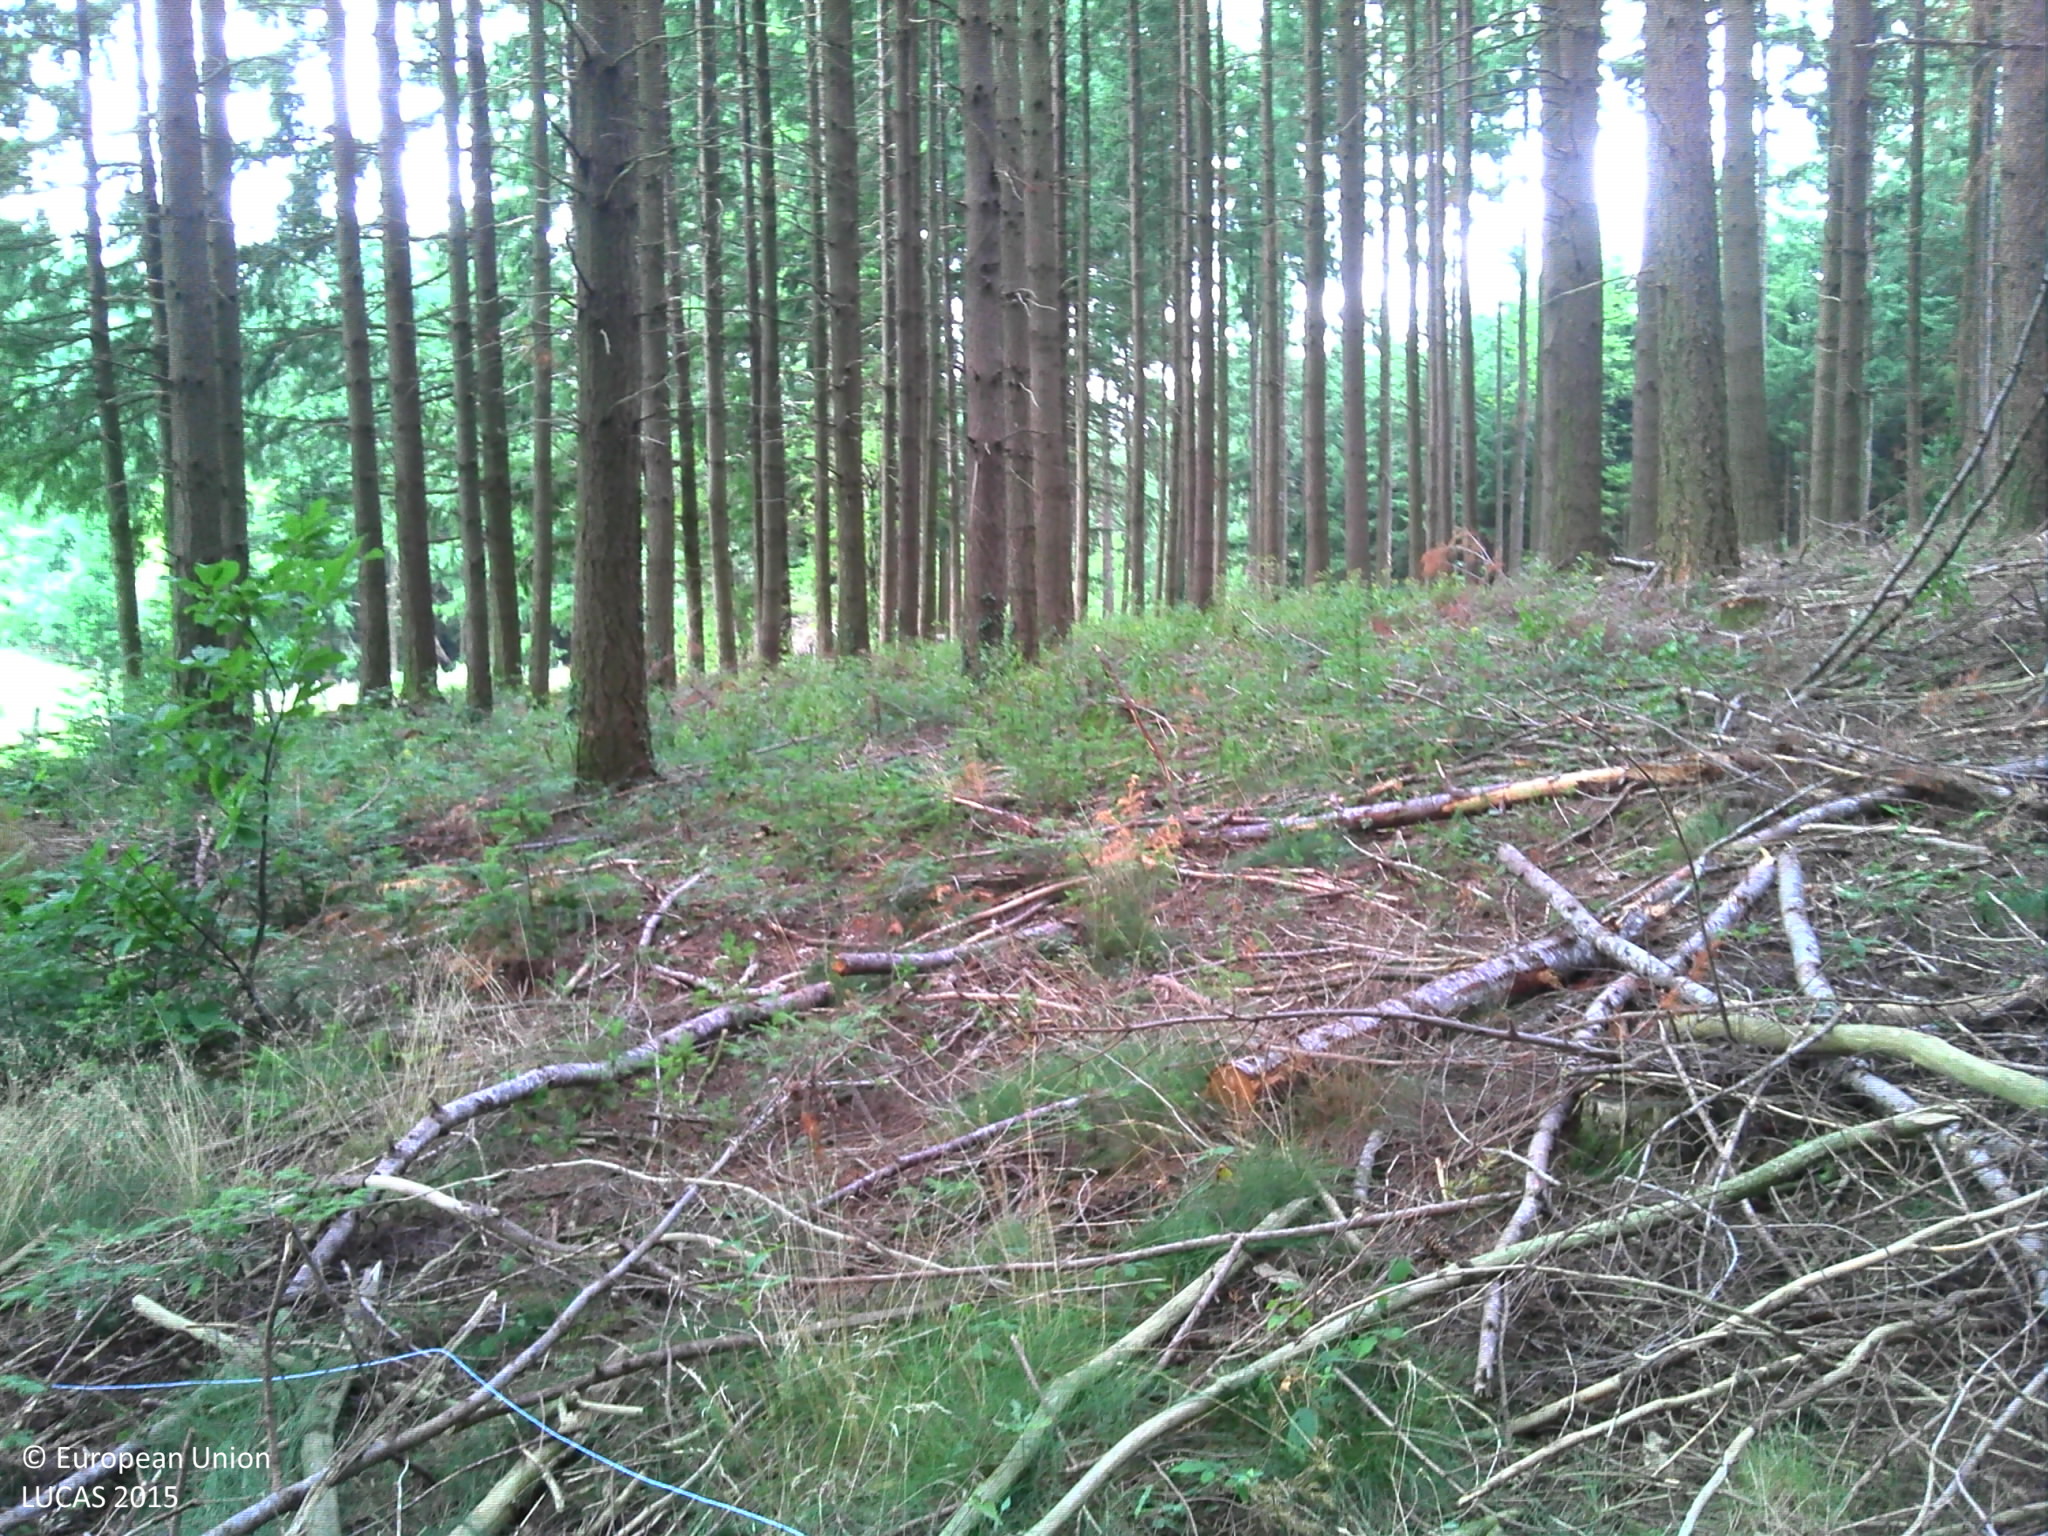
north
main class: Woodland
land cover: Spruce dominated coniferous woodland
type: exotic forest
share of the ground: > 75 %
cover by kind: coniferous forest trees 80 %, herbaceous plants 20 %
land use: Forestry
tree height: > 5 m
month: August
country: FR
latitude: 46.2606
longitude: 4.4362
